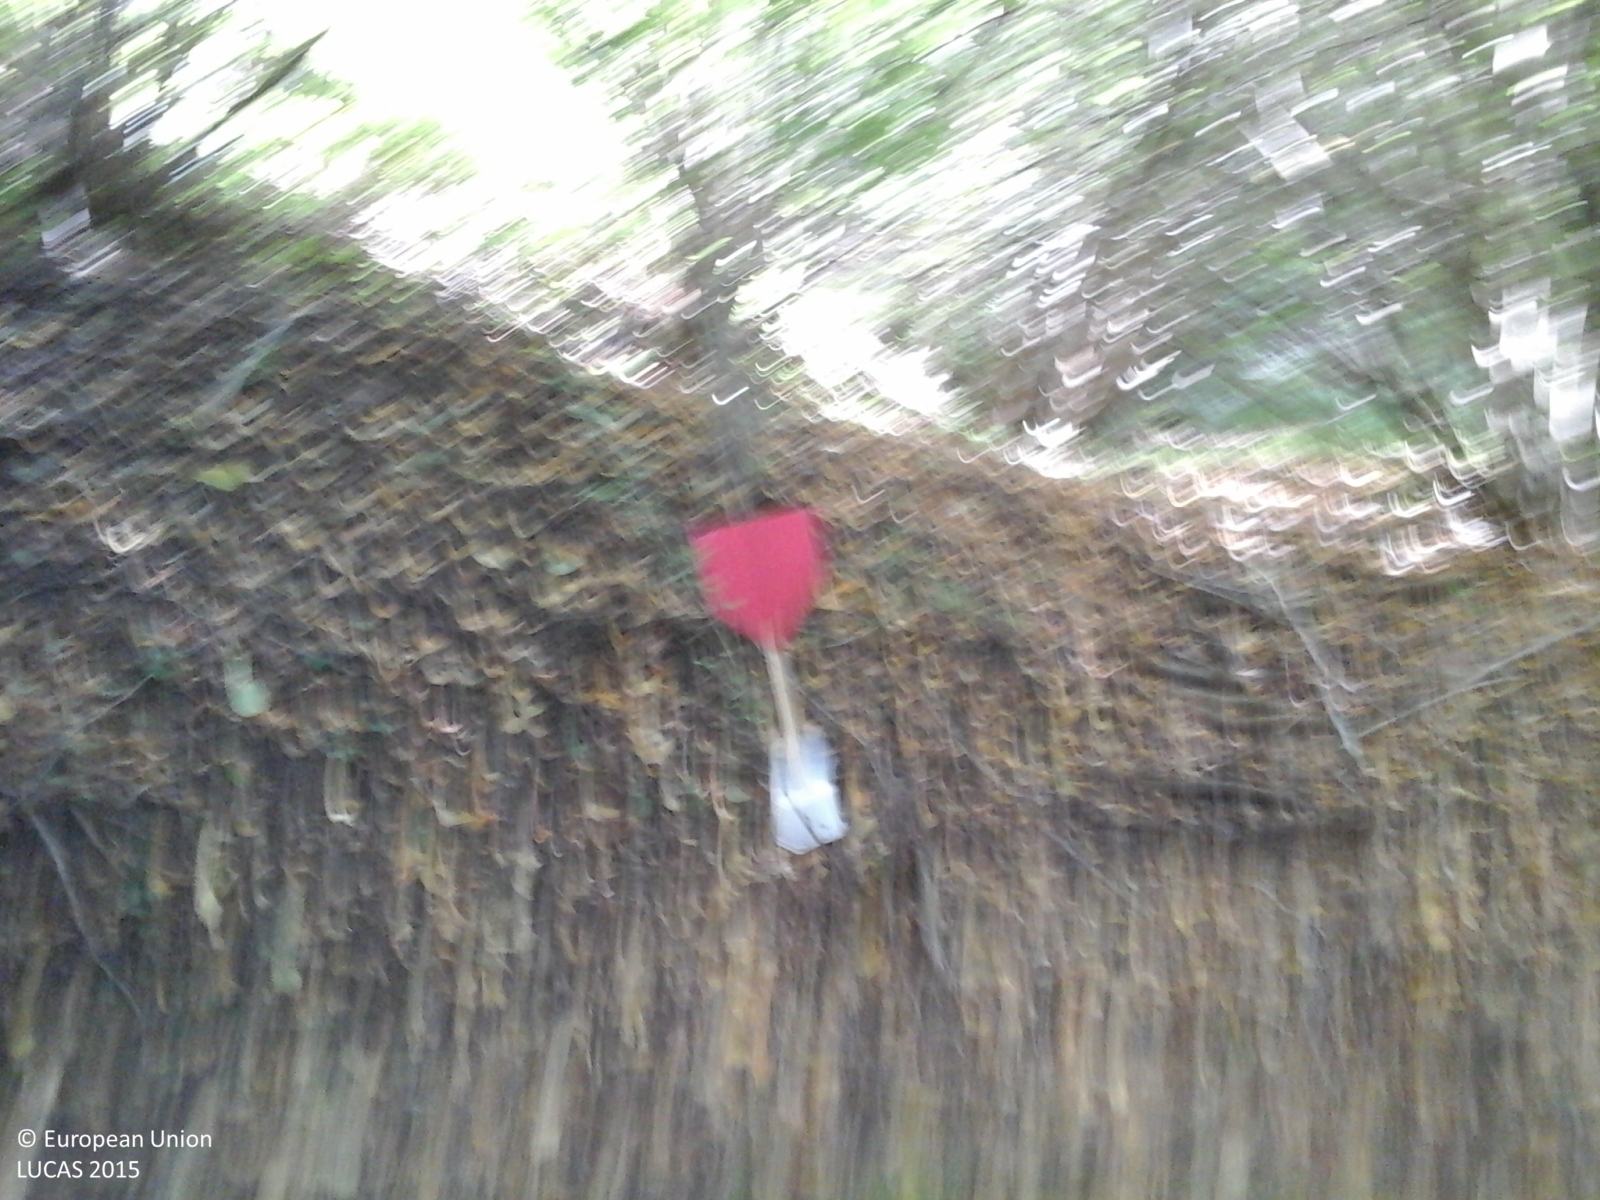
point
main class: Woodland
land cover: Broadleaved woodland
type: thermophilous deciduous forest
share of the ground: > 75 %
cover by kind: broadleaved forest trees 80 %, shrubs 20 %
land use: Semi-natural and natural areas not in use
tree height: > 5 m
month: September
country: IT
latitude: 44.5018
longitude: 8.4814
